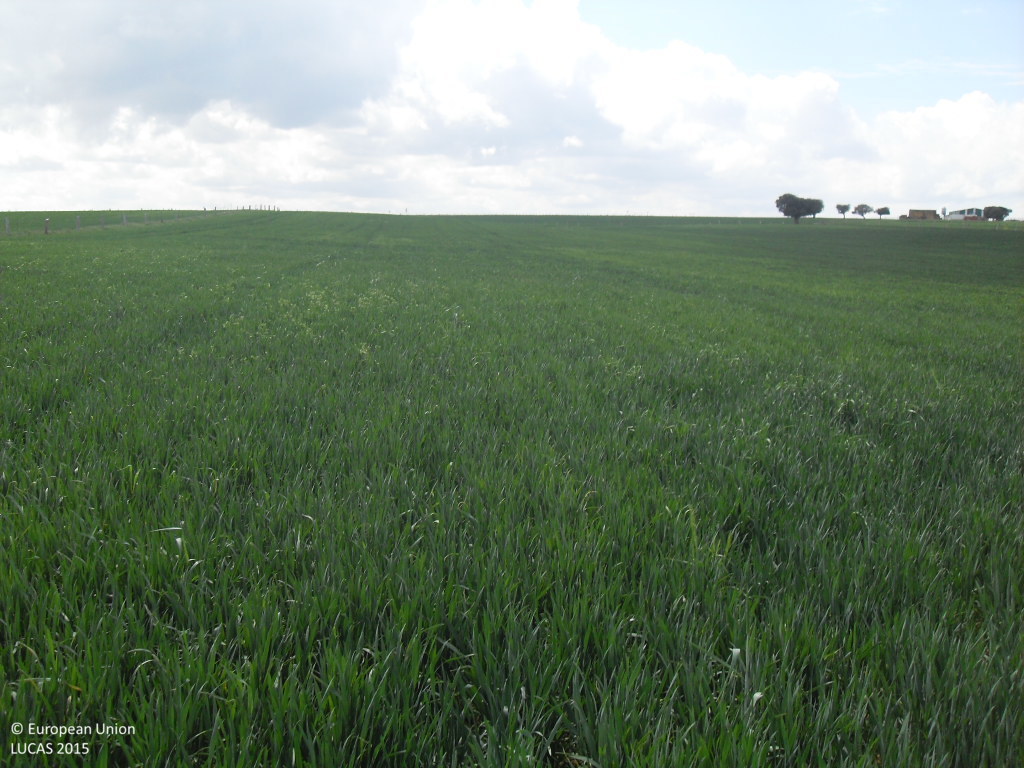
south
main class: Cropland
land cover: Common wheat
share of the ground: > 75 %
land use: Agriculture (excluding fallow land and kitchen gardens)
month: April
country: ES
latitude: 40.7478
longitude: -5.3100
